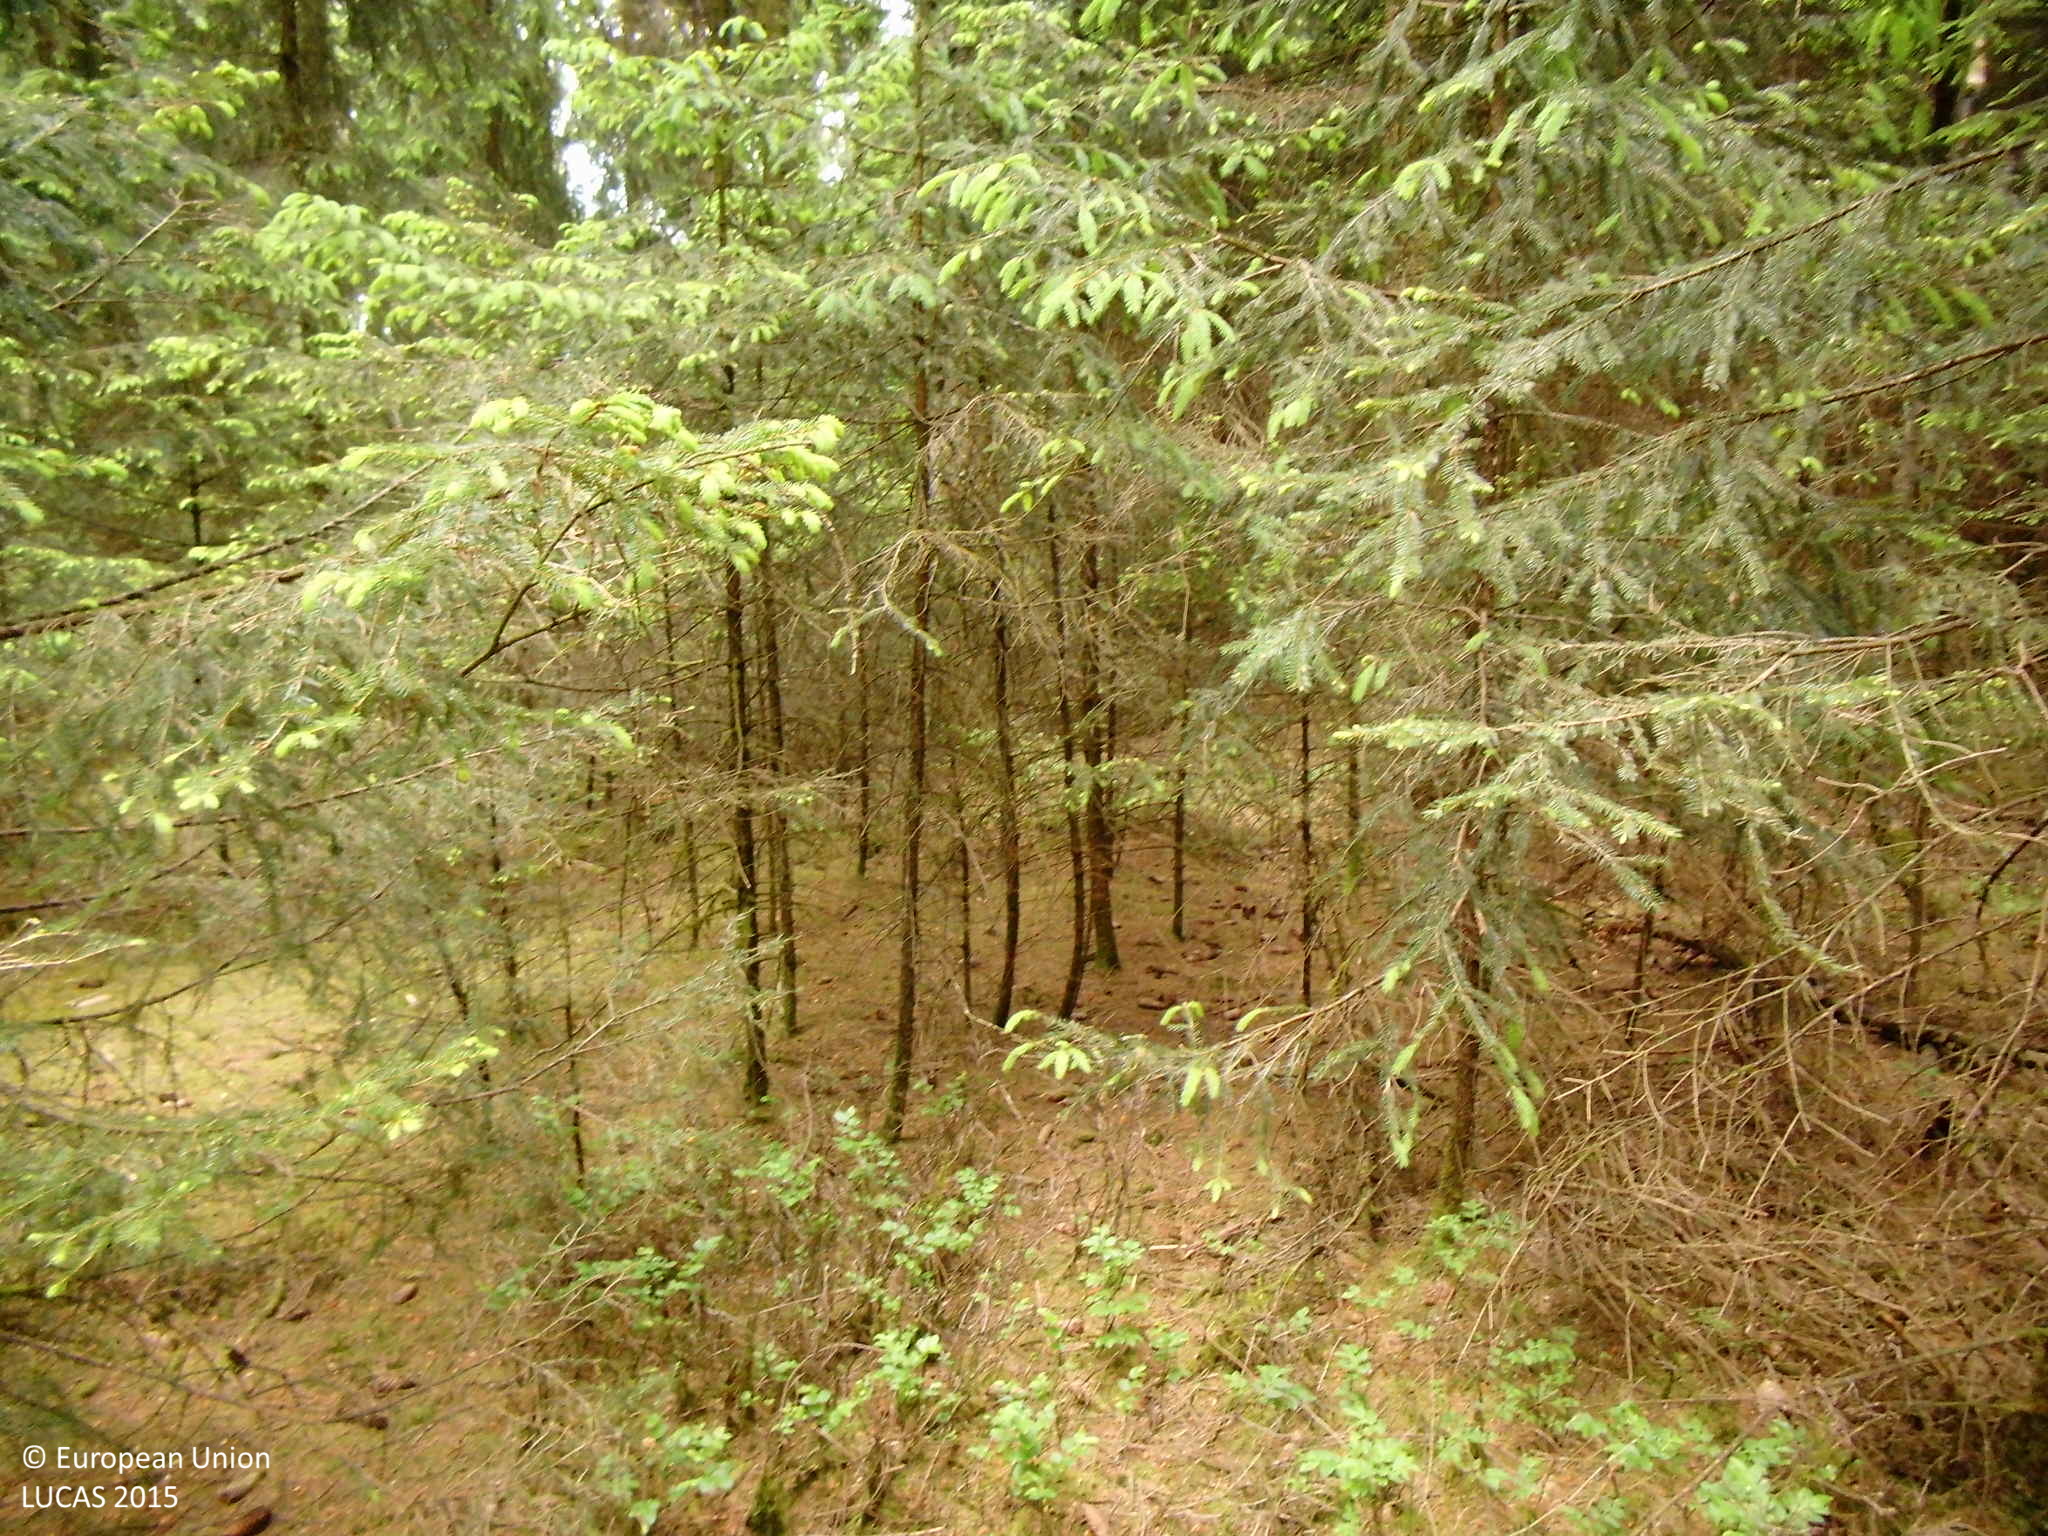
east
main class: Woodland
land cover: Spruce dominated coniferous woodland
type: hemiboreal forest and nemoral coniferous forest and mixed broadleaved-coniferous forest
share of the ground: > 75 %
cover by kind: coniferous forest trees 75 %, lichens and mosses 15 %, broadleaved forest trees 5 %, herbaceous plants 5 %
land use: Forestry
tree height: > 5 m
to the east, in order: Spruce dominated coniferous woodland; Ditches and canals; Shruby margins; Tracks; Shruby margins; Broadleaved woodland; Spruce dominated mixed woodland; Shruby margins; Tracks; Shruby margins; Spruce dominated mixed woodland; Broadleaved woodland; Fences; Grassland without tree/shrub cover; Ditches and canals; Shruby margins; Fences; Other mixed woodland
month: June
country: DE
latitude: 51.0478
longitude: 7.9891
